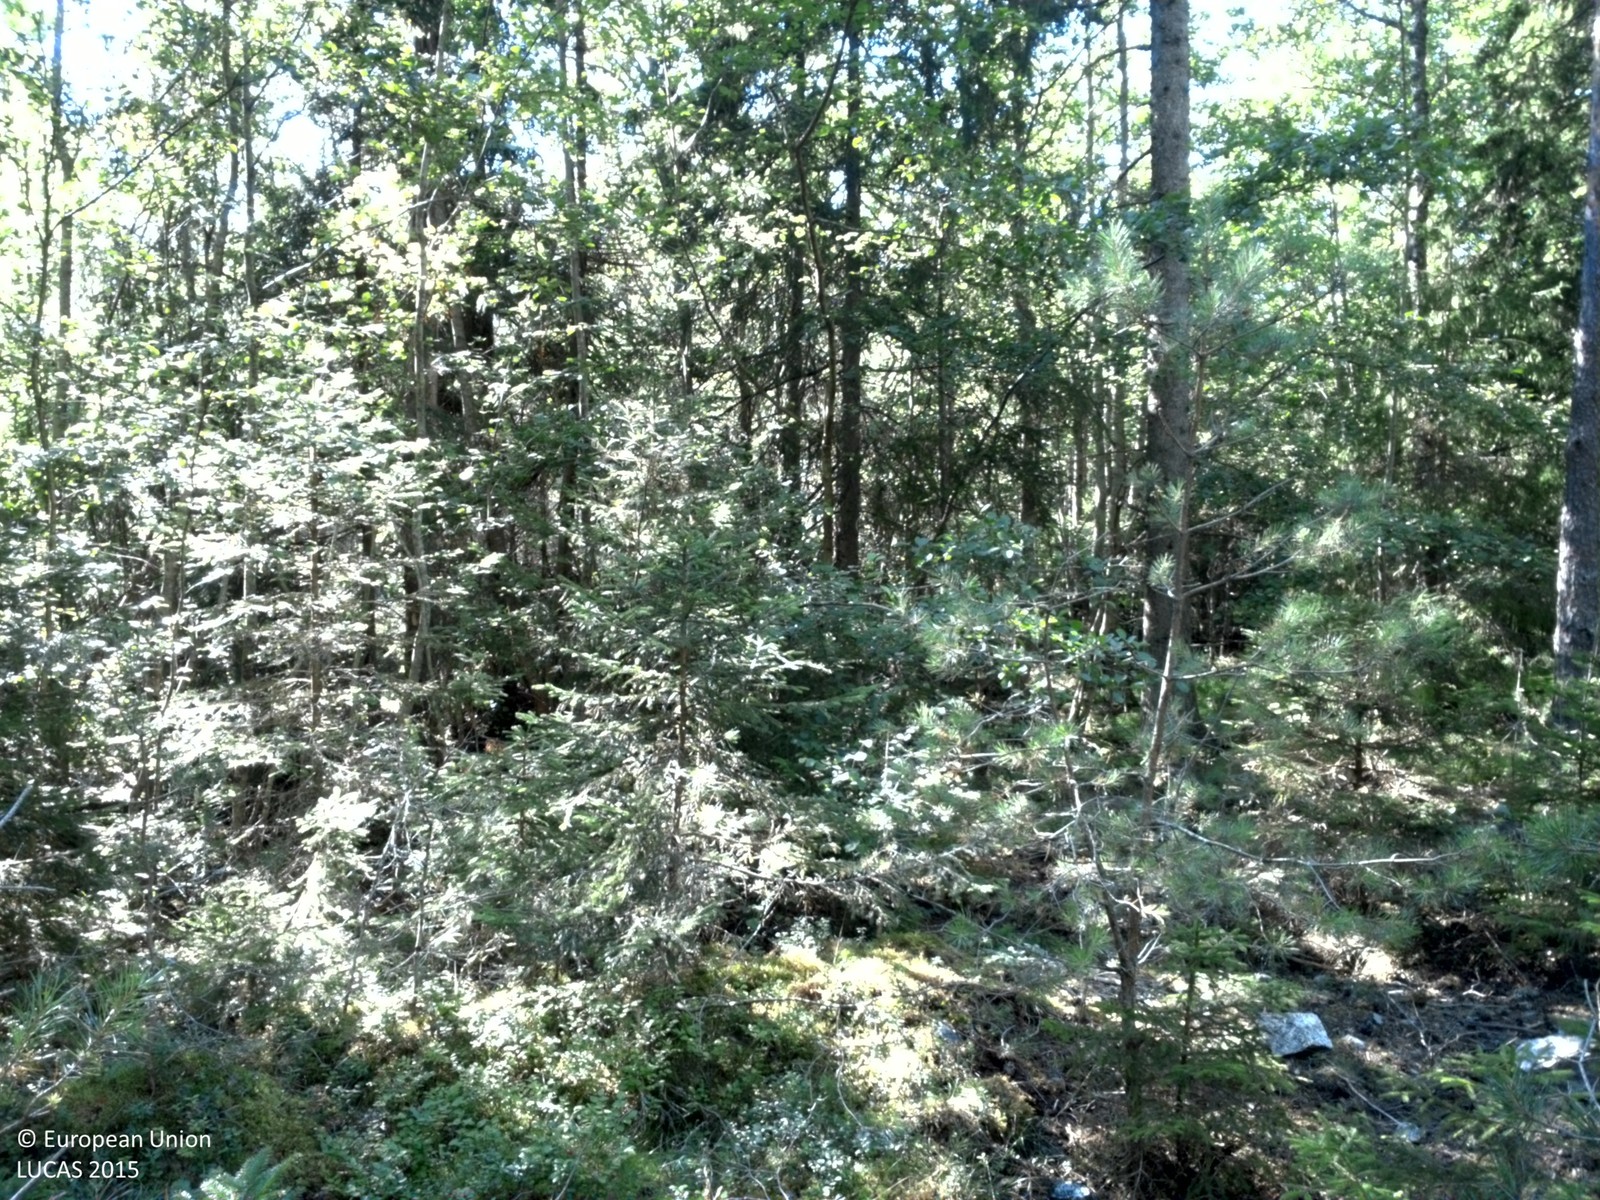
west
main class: Woodland
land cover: Other coniferous woodland
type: boreal forest
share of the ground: > 75 %
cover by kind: coniferous forest trees 85 %, lichens and mosses 15 %
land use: Amenities, museums, leisure
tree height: > 5 m
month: August
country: SE
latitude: 59.6872
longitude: 17.5796
